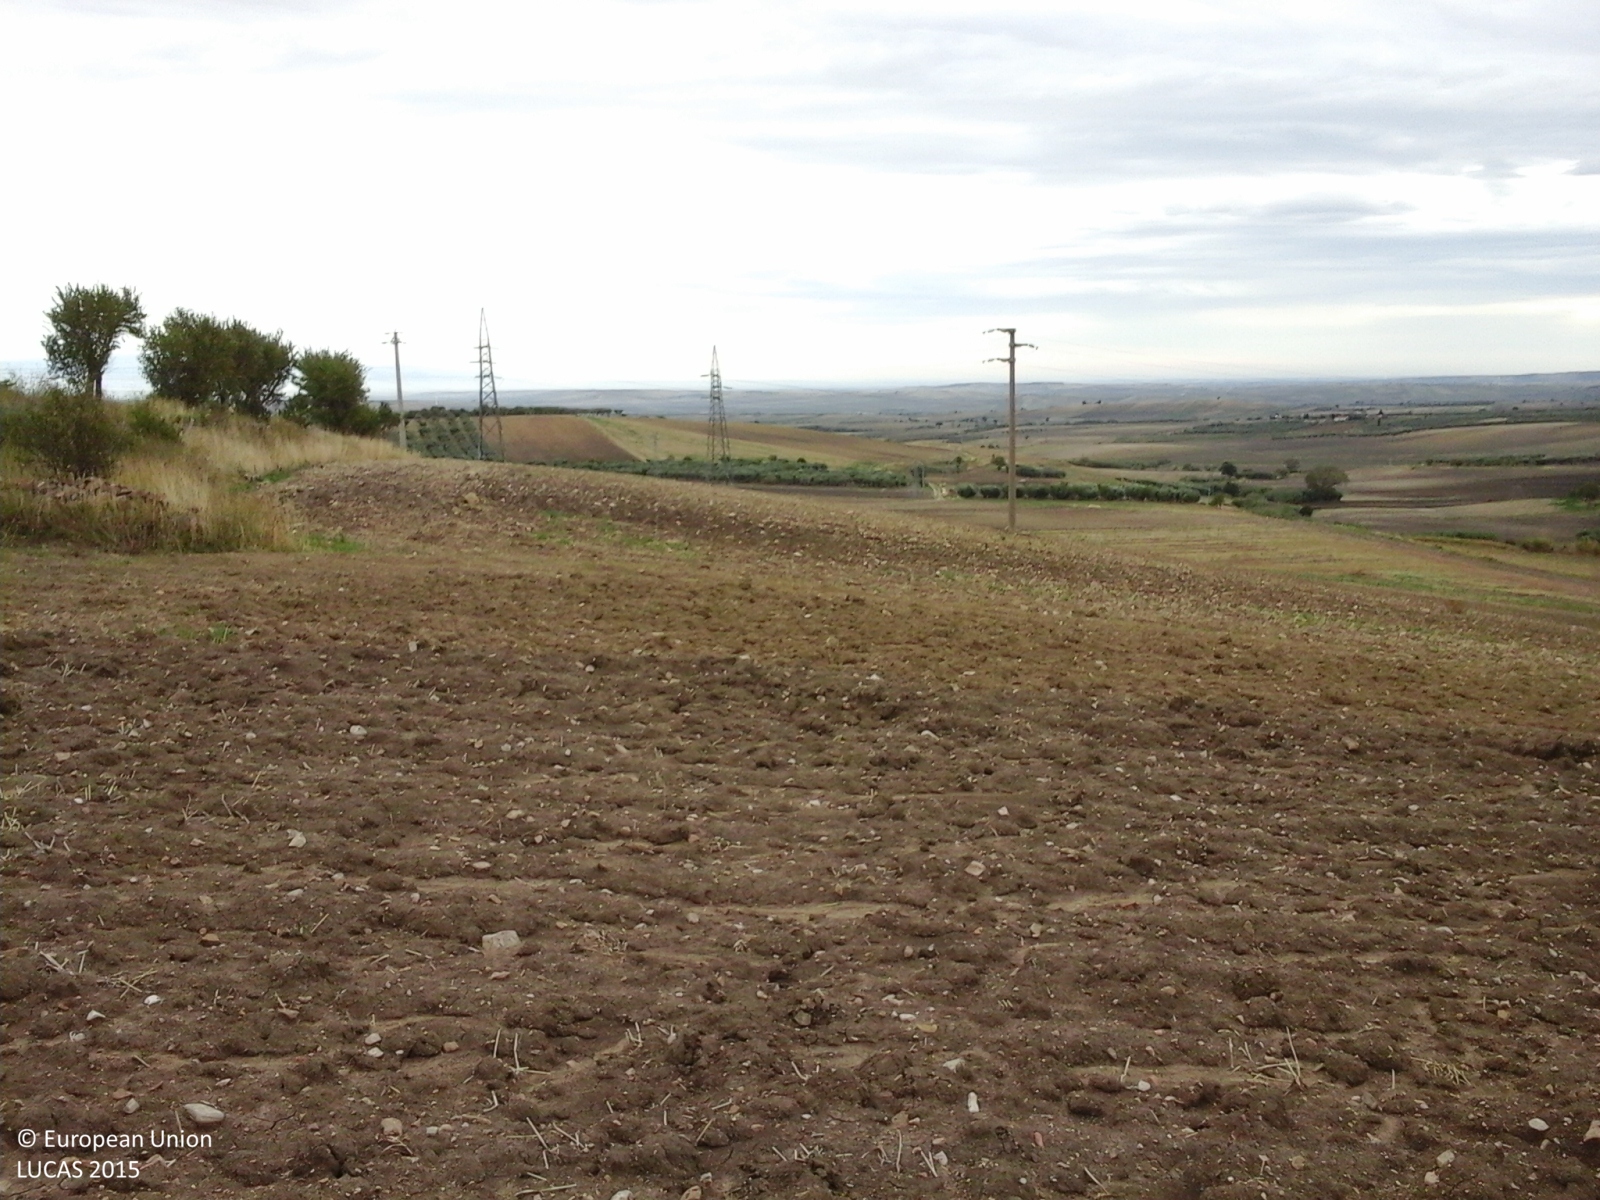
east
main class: Cropland
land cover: Barley
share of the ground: > 75 %
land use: Agriculture (excluding fallow land and kitchen gardens)
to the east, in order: Barley; Electric lines; Durum wheat; Electric lines; Durum wheat; Electric lines; Durum wheat
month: October
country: IT
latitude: 41.6009
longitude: 15.1303
